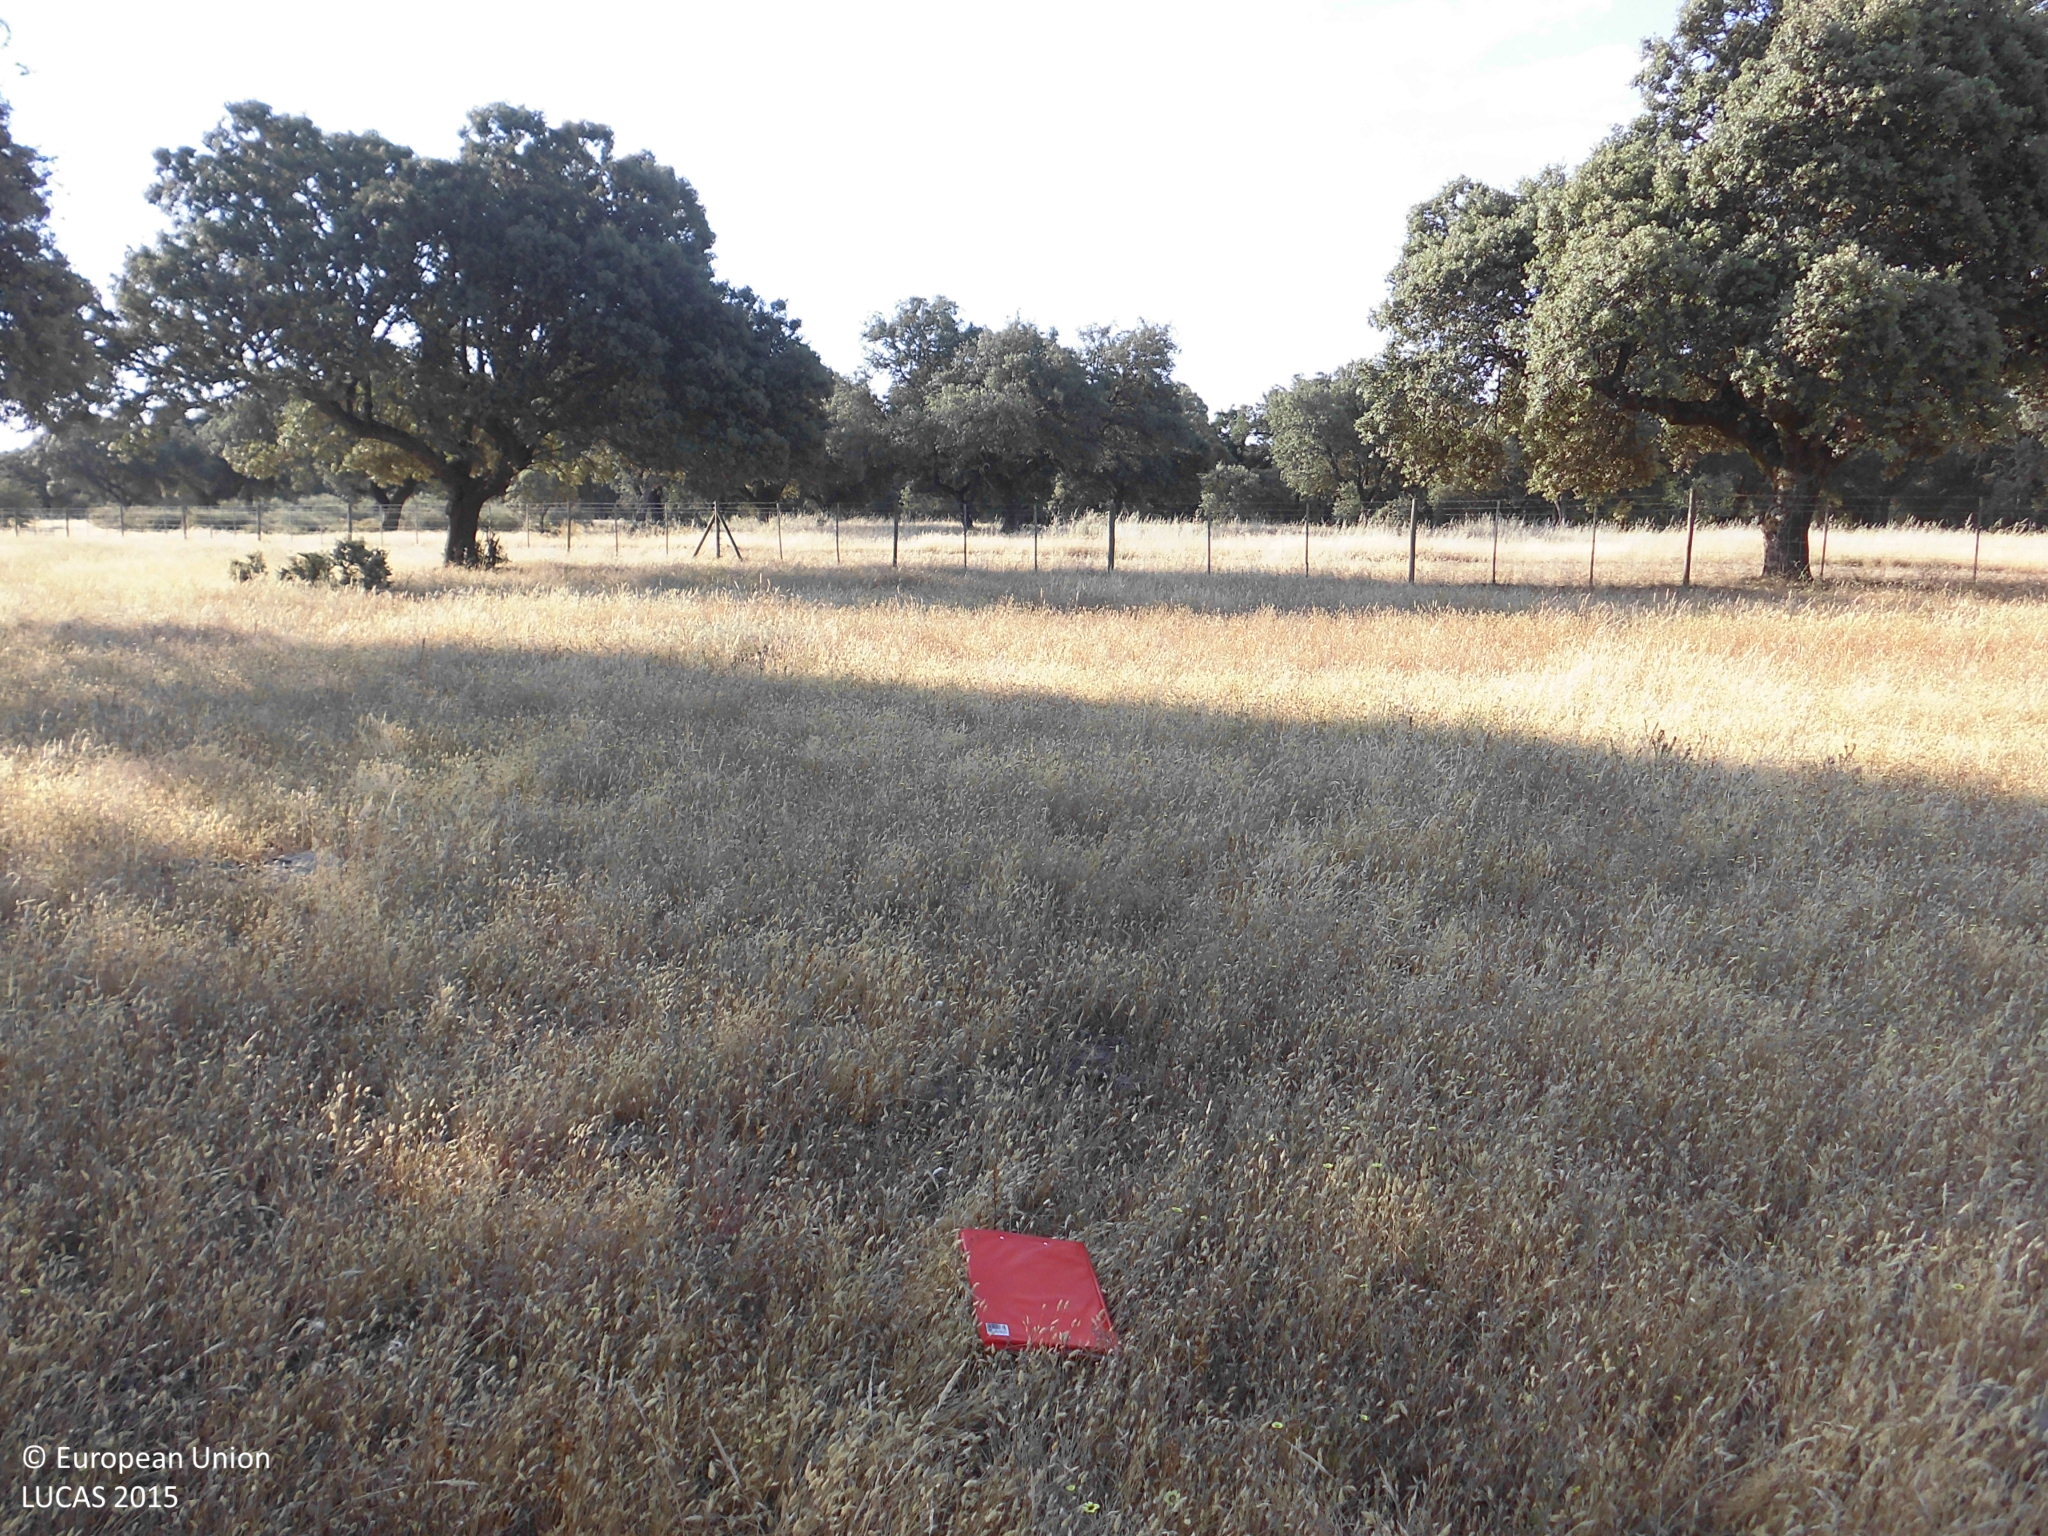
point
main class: Woodland
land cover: Broadleaved woodland
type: broadleaved evergreen forest
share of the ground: 10 - 25 %
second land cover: Grassland without tree/shrub cover
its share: > 75 %
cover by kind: herbaceous plants 80 %, broadleaved forest trees 20 %
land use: Forestry
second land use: Agriculture (excluding fallow land and kitchen gardens)
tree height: > 5 m
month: June
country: ES
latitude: 39.9791
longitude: -5.4093
